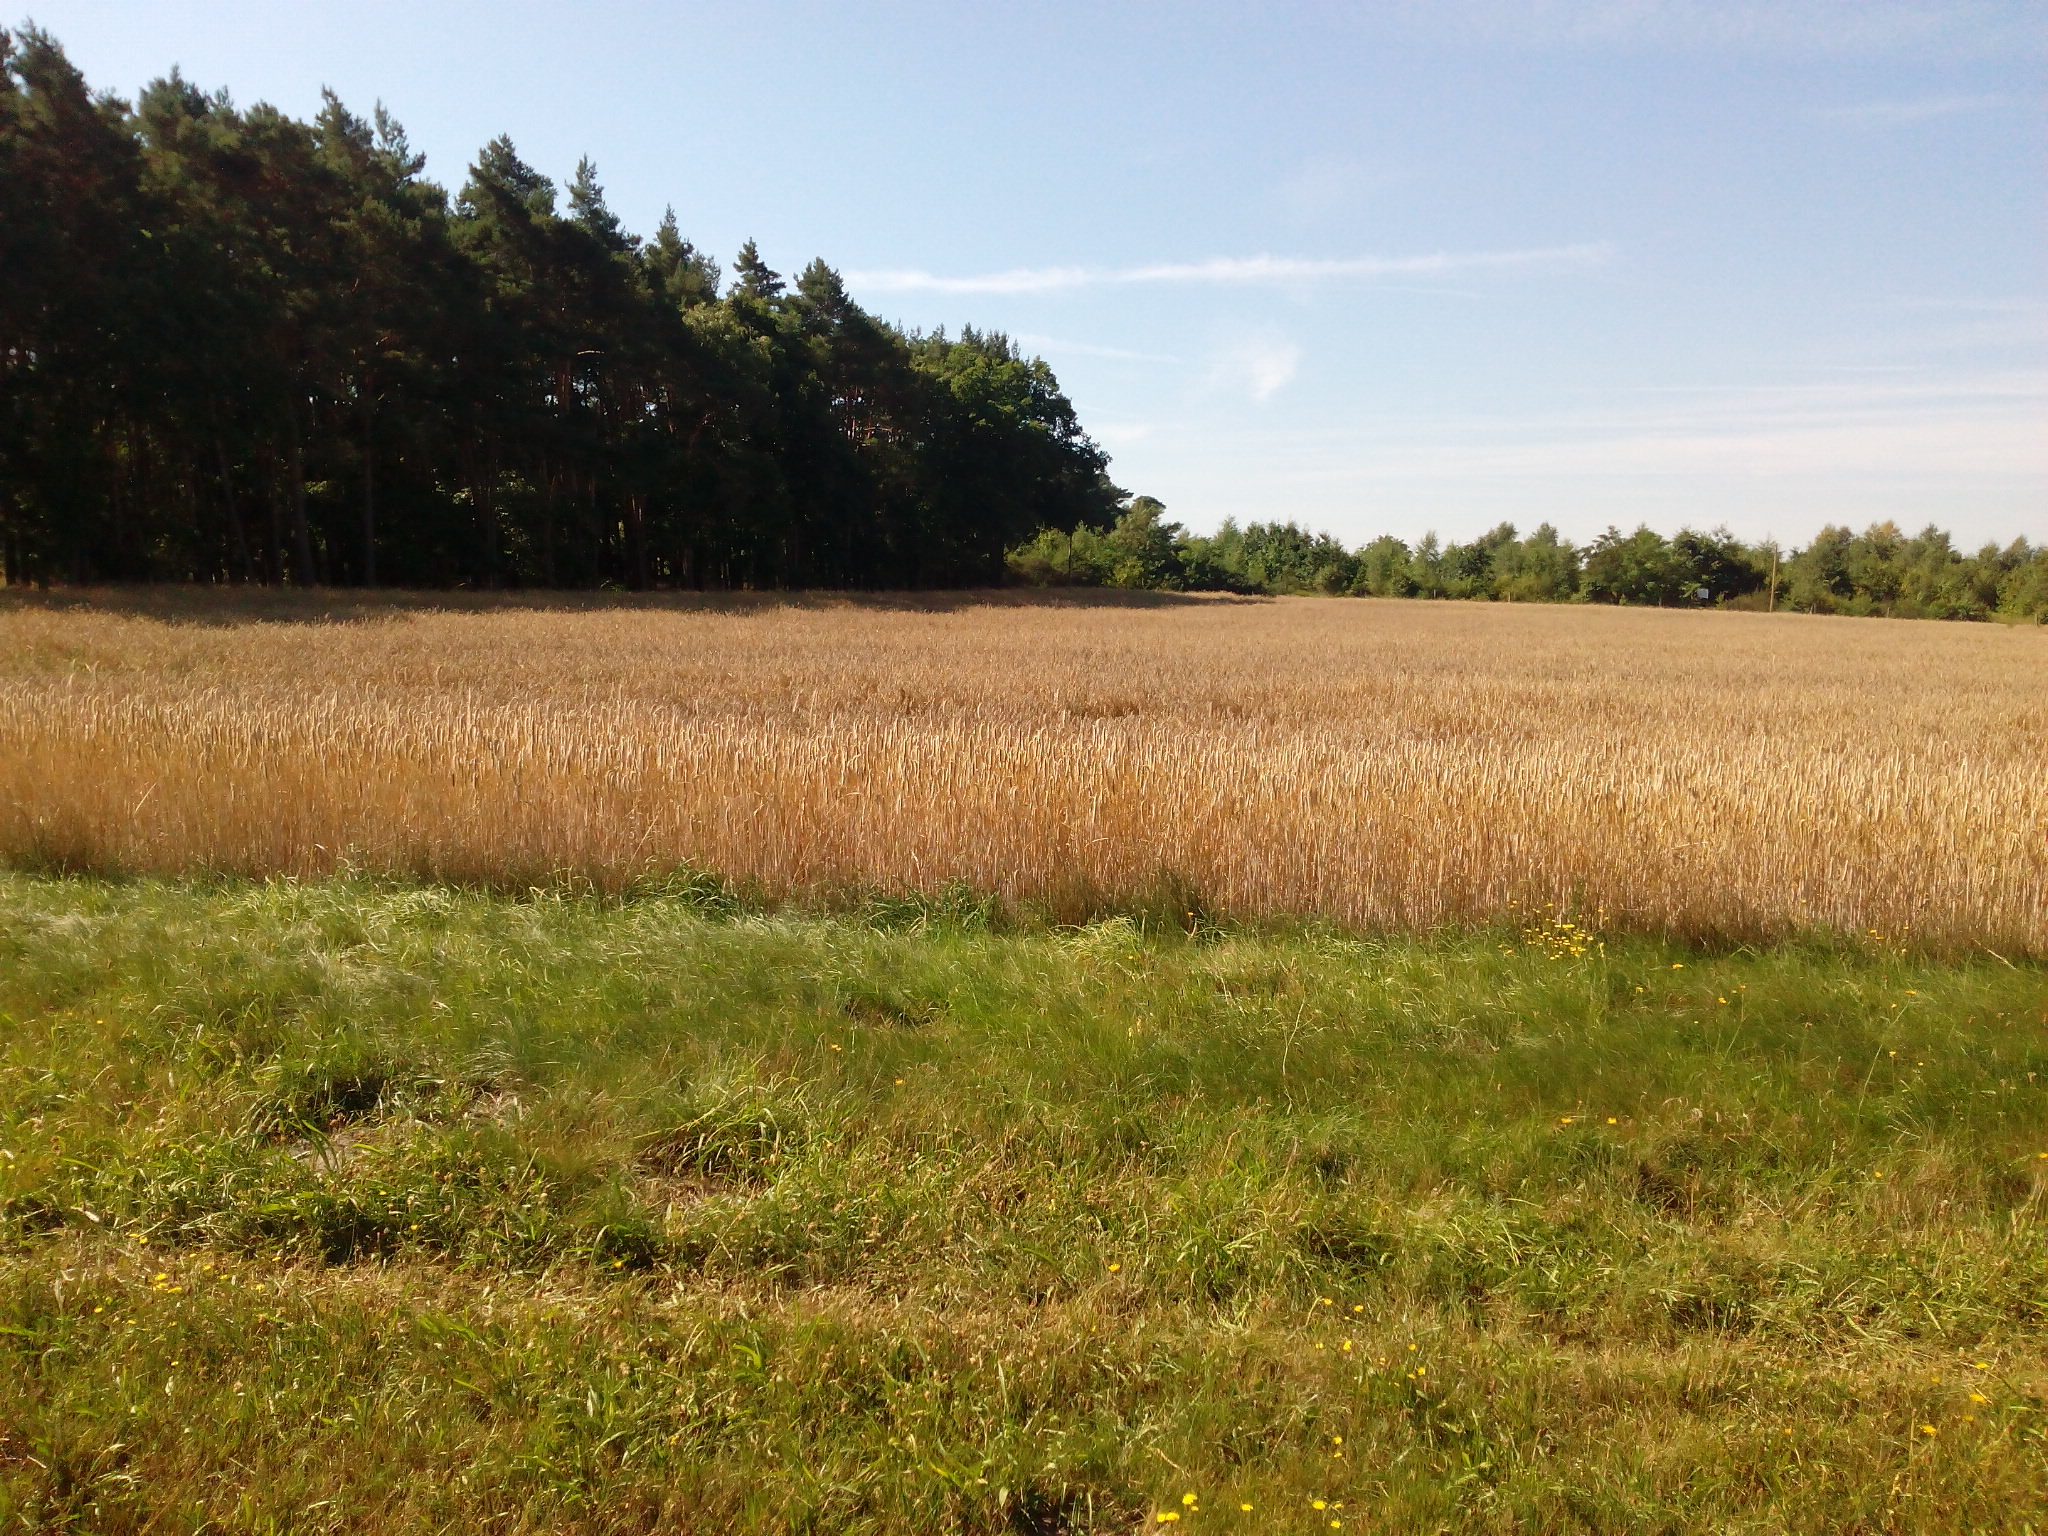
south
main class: Cropland
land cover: Rye
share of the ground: > 75 %
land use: Agriculture (excluding fallow land and kitchen gardens)
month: August
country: DE
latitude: 52.5212
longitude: 9.8969
